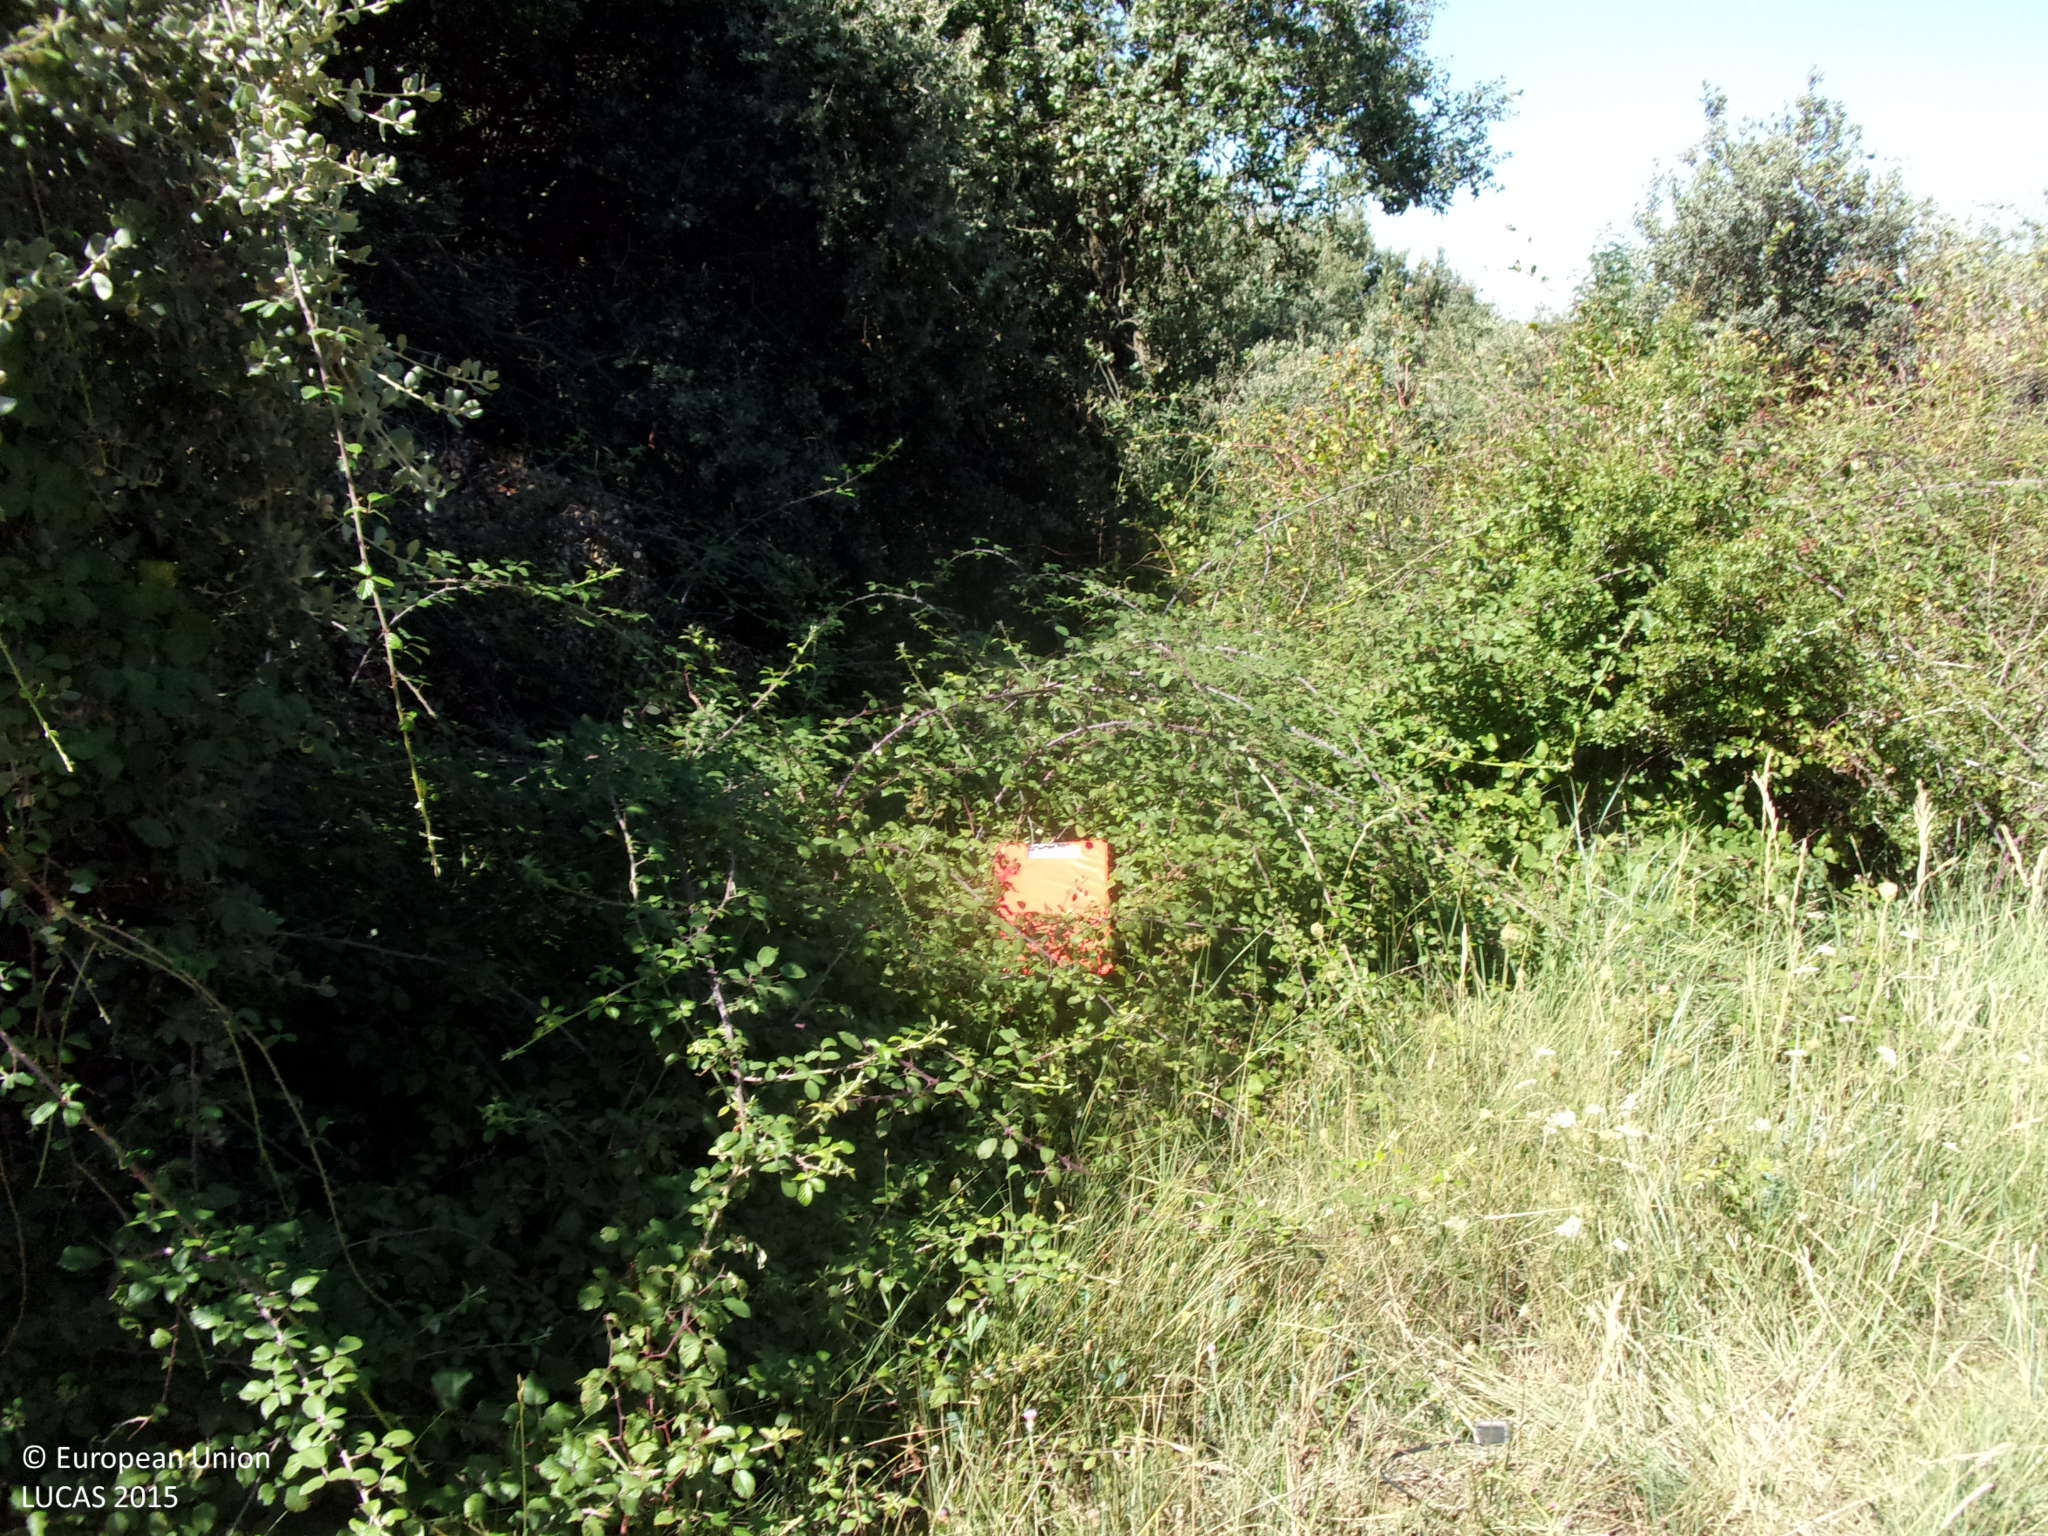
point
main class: Woodland
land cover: Broadleaved woodland
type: thermophilous deciduous forest
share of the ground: > 75 %
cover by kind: broadleaved forest trees 90 %, shrubs 10 %
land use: Forestry
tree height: < 5 m
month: August
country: ES
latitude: 42.3805
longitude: -1.1680
